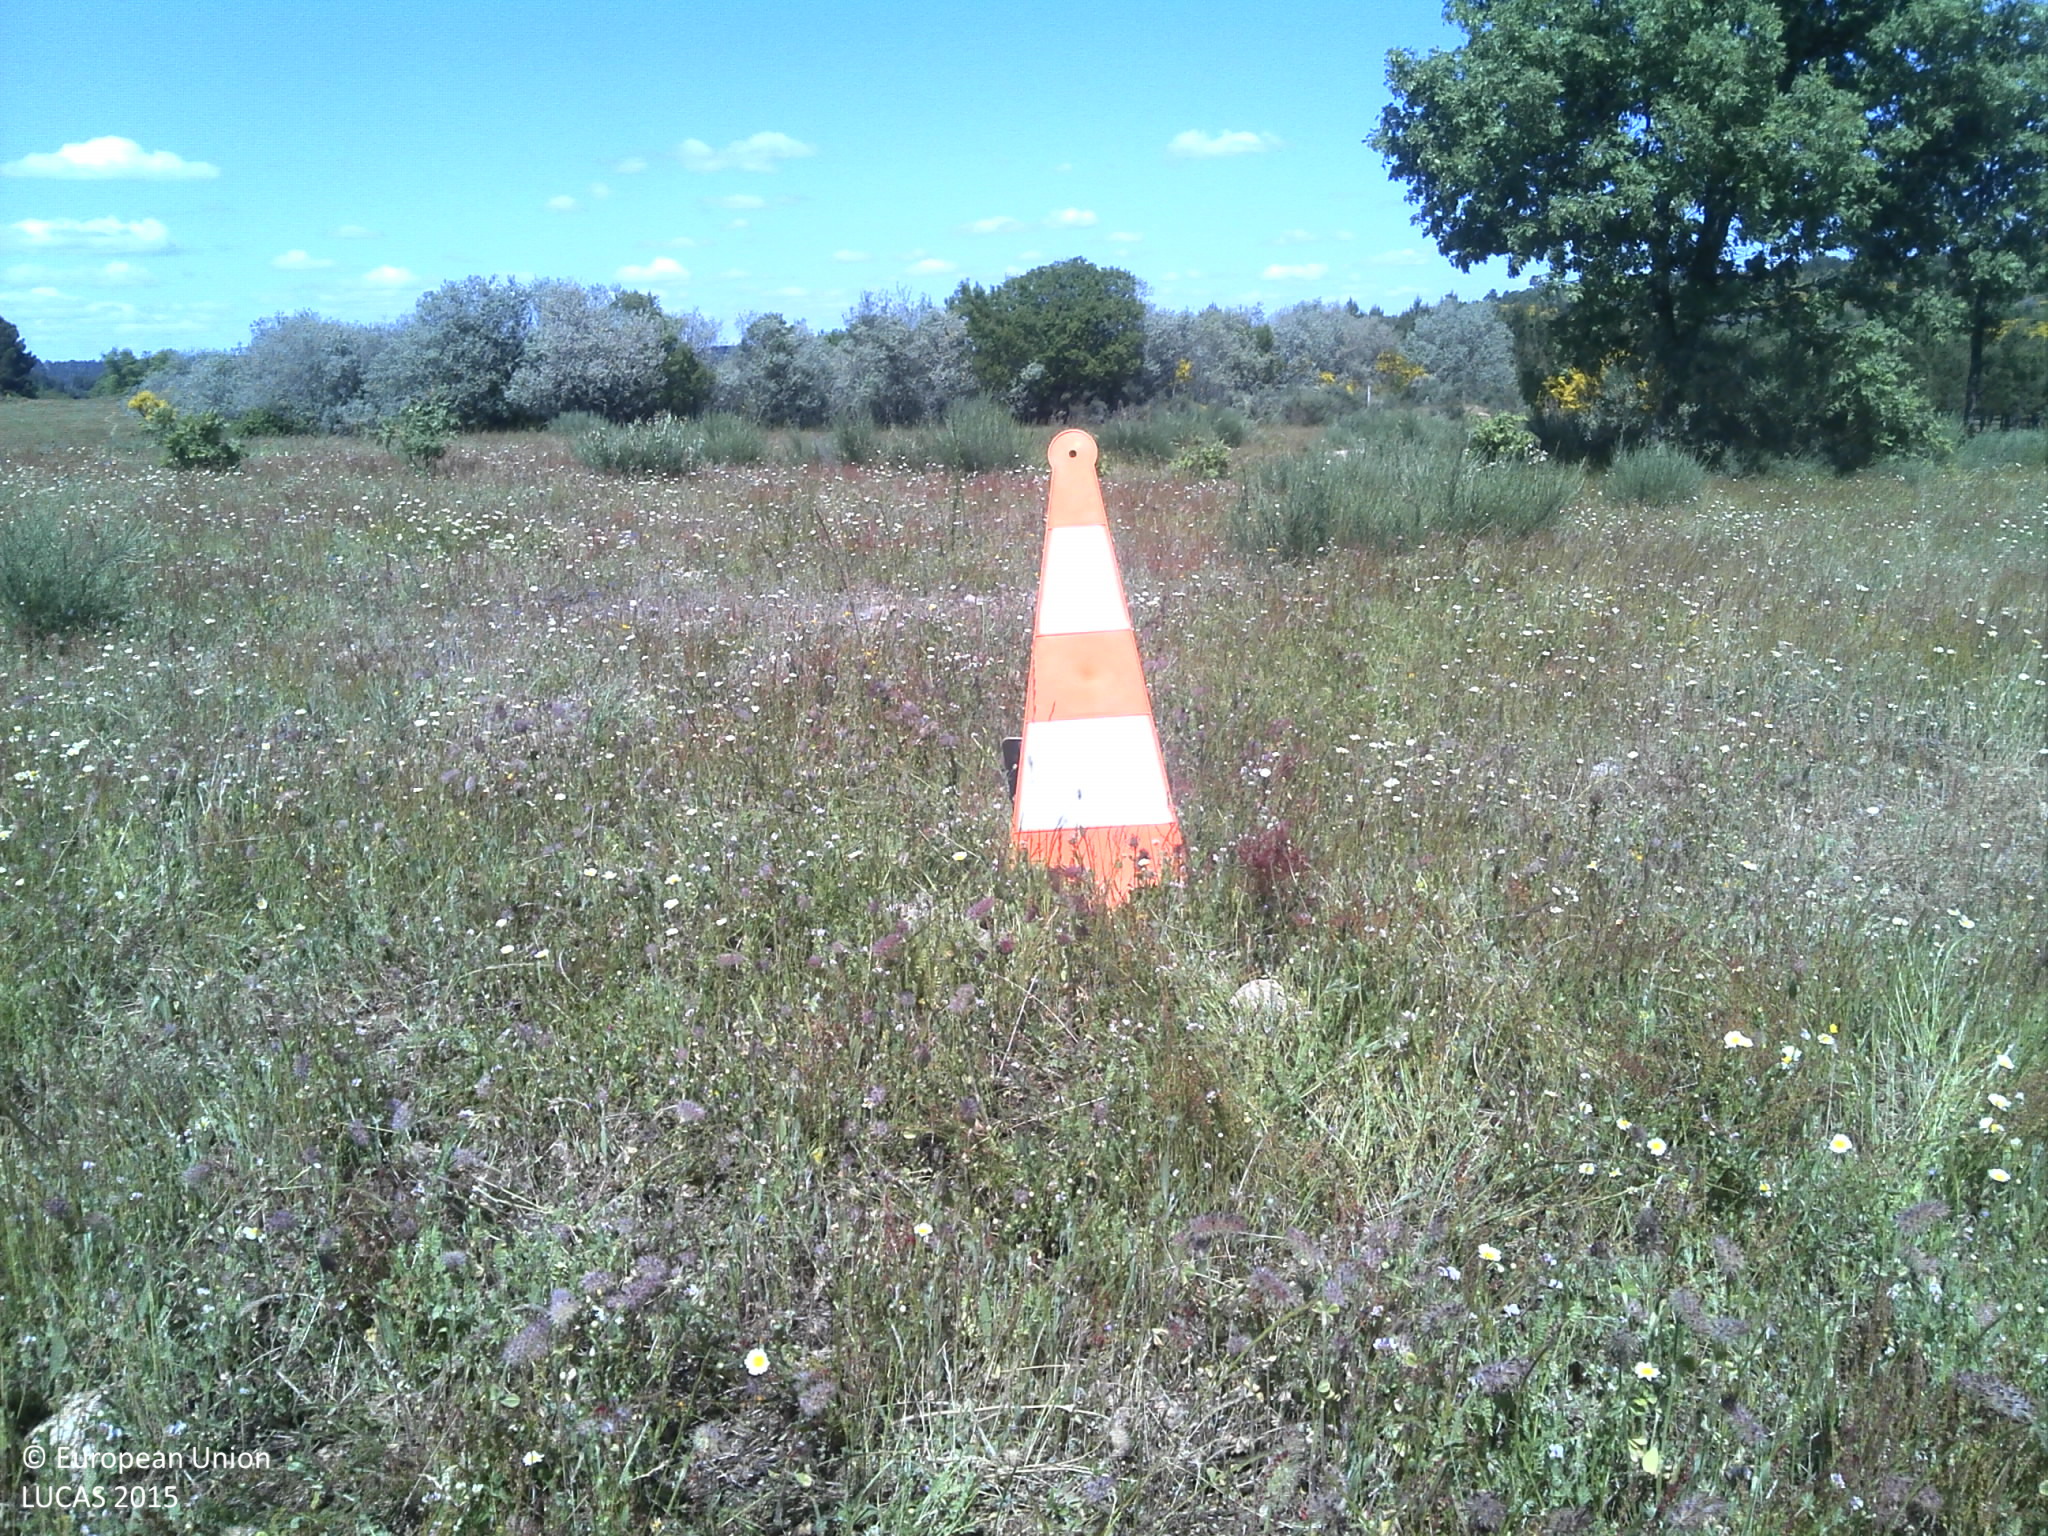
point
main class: Grassland
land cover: Grassland with sparse tree/shrub cover
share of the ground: 50 - 75 %
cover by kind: herbaceous plants 65 %, consolidated bare surface 20 %, broadleaved forest trees 5 %
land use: Agriculture (excluding fallow land and kitchen gardens)
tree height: < 5 m
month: May
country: PT
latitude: 40.4879
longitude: -7.1982
